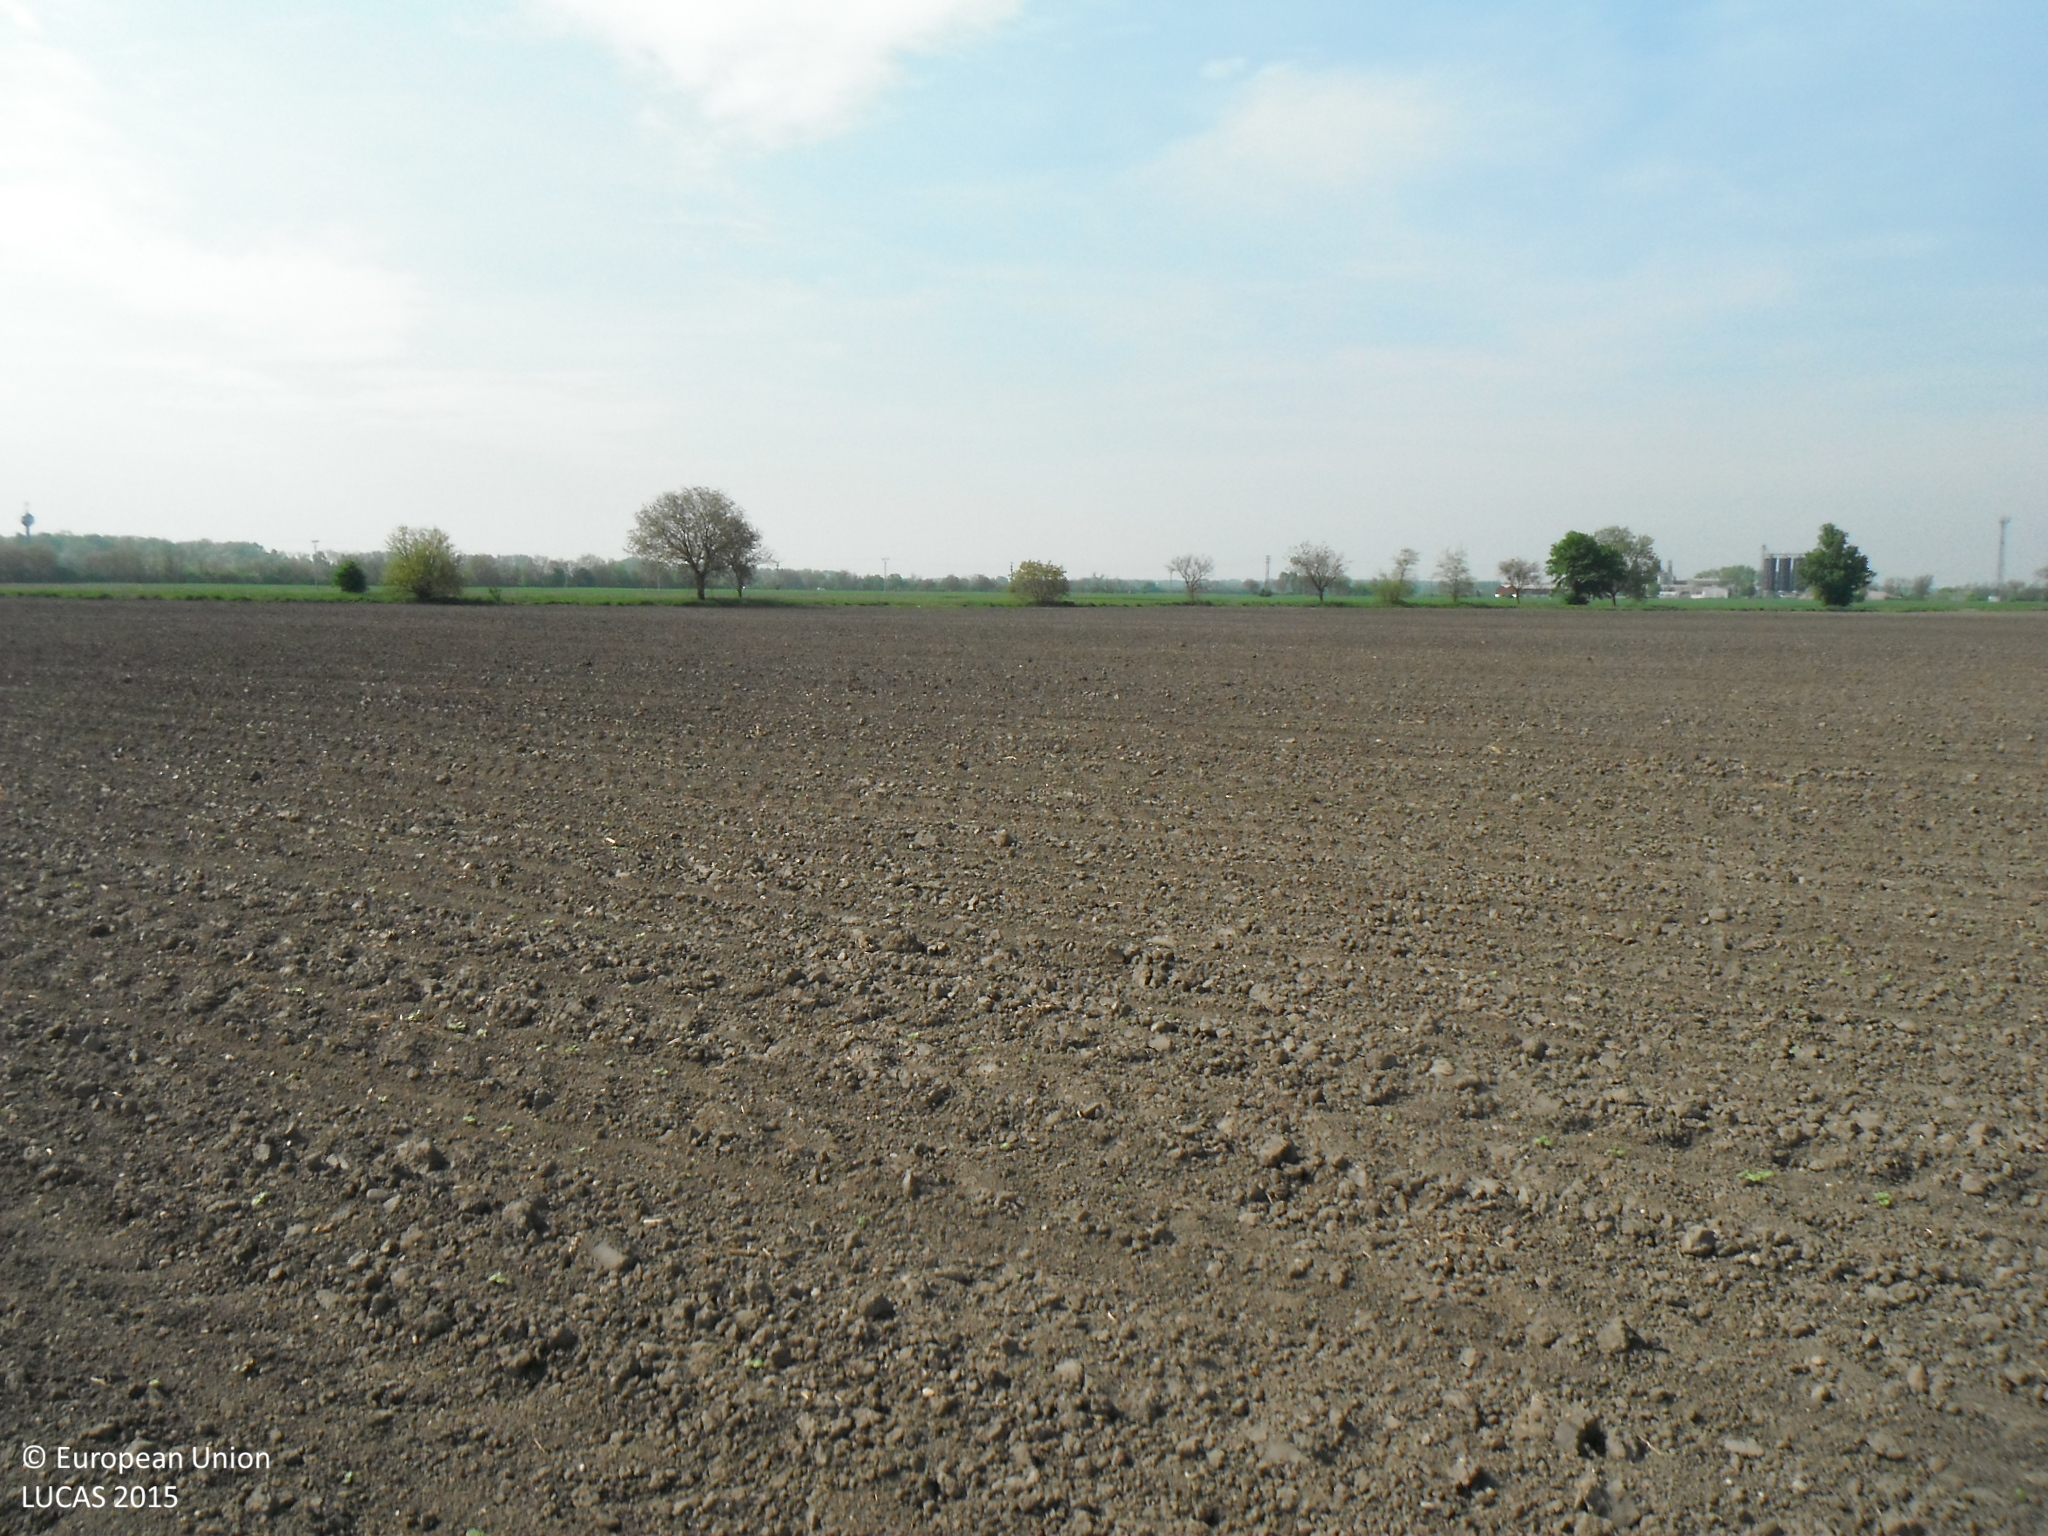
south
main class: Cropland
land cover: Sunflower
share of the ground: < 10 %
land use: Agriculture (excluding fallow land and kitchen gardens)
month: May
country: SK
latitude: 48.0111
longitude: 17.3954
